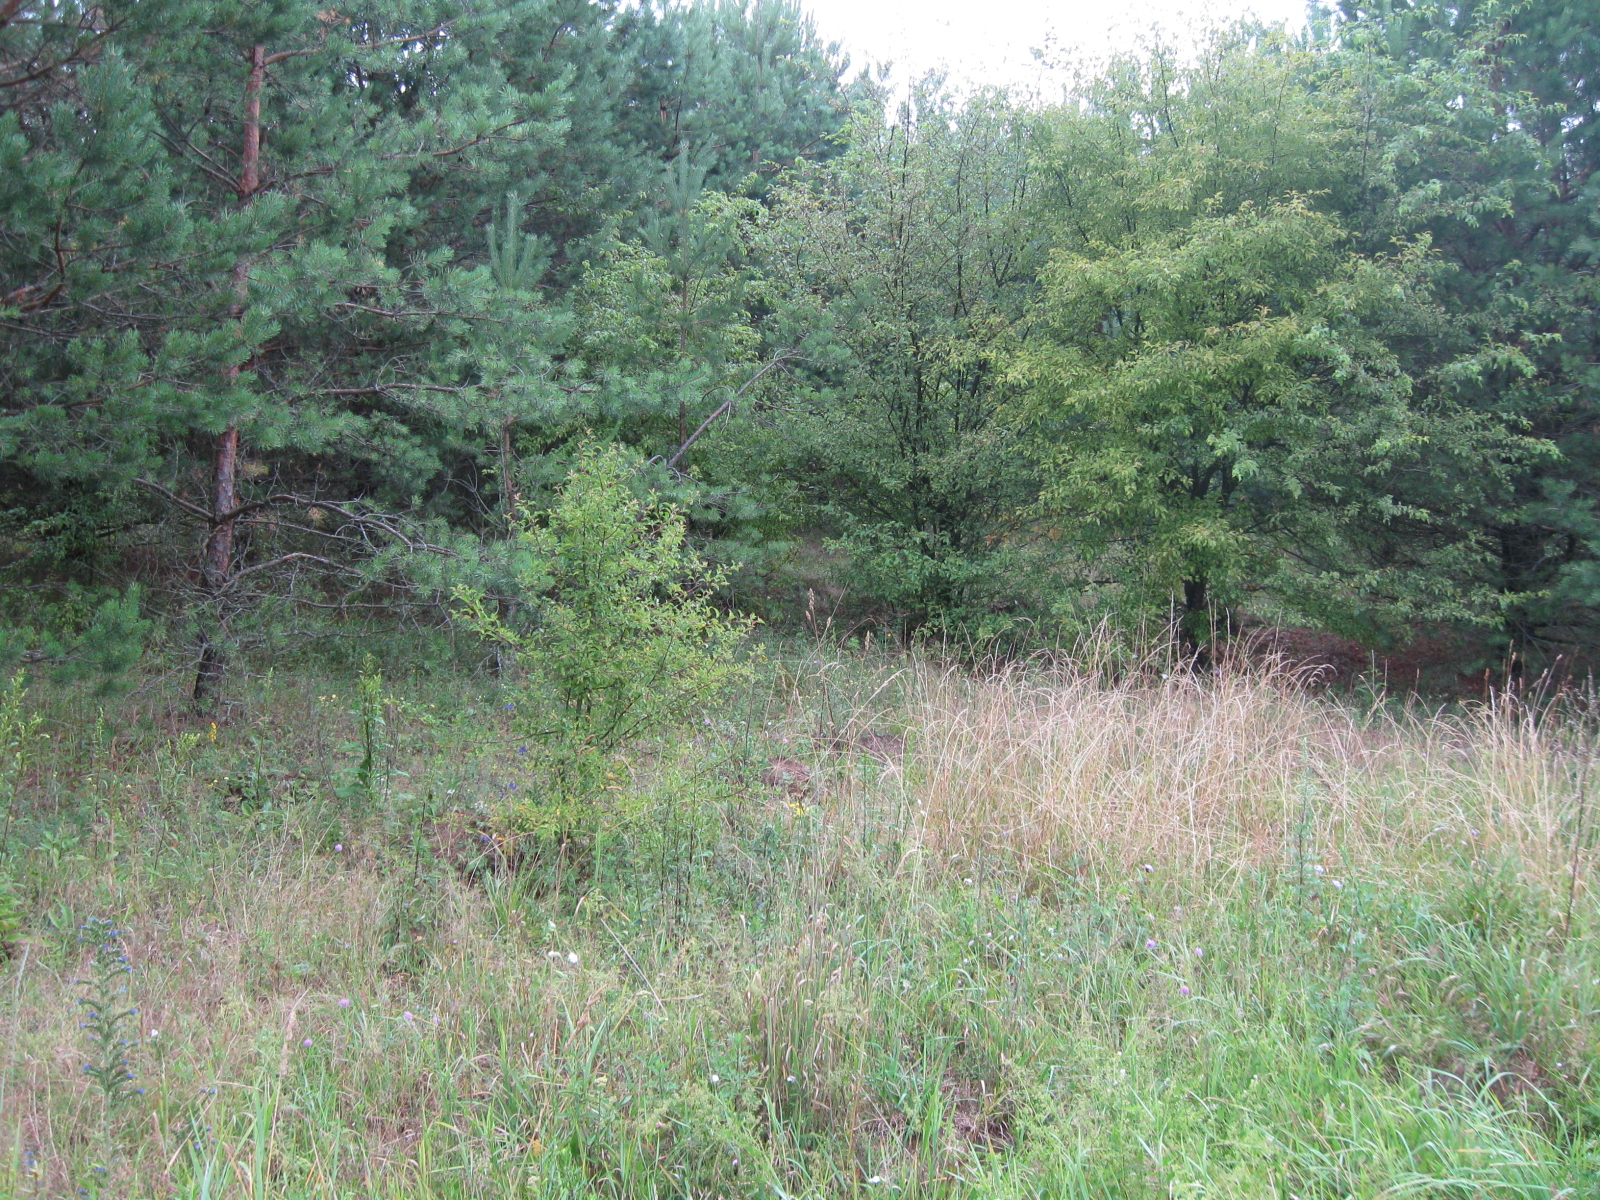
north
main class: Grassland
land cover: Grassland with sparse tree/shrub cover
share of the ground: > 75 %
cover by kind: herbaceous plants 90 %, broadleaved forest trees 5 %, shrubs 5 %
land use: Forestry
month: July
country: LT
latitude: 54.0320
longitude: 23.6275
